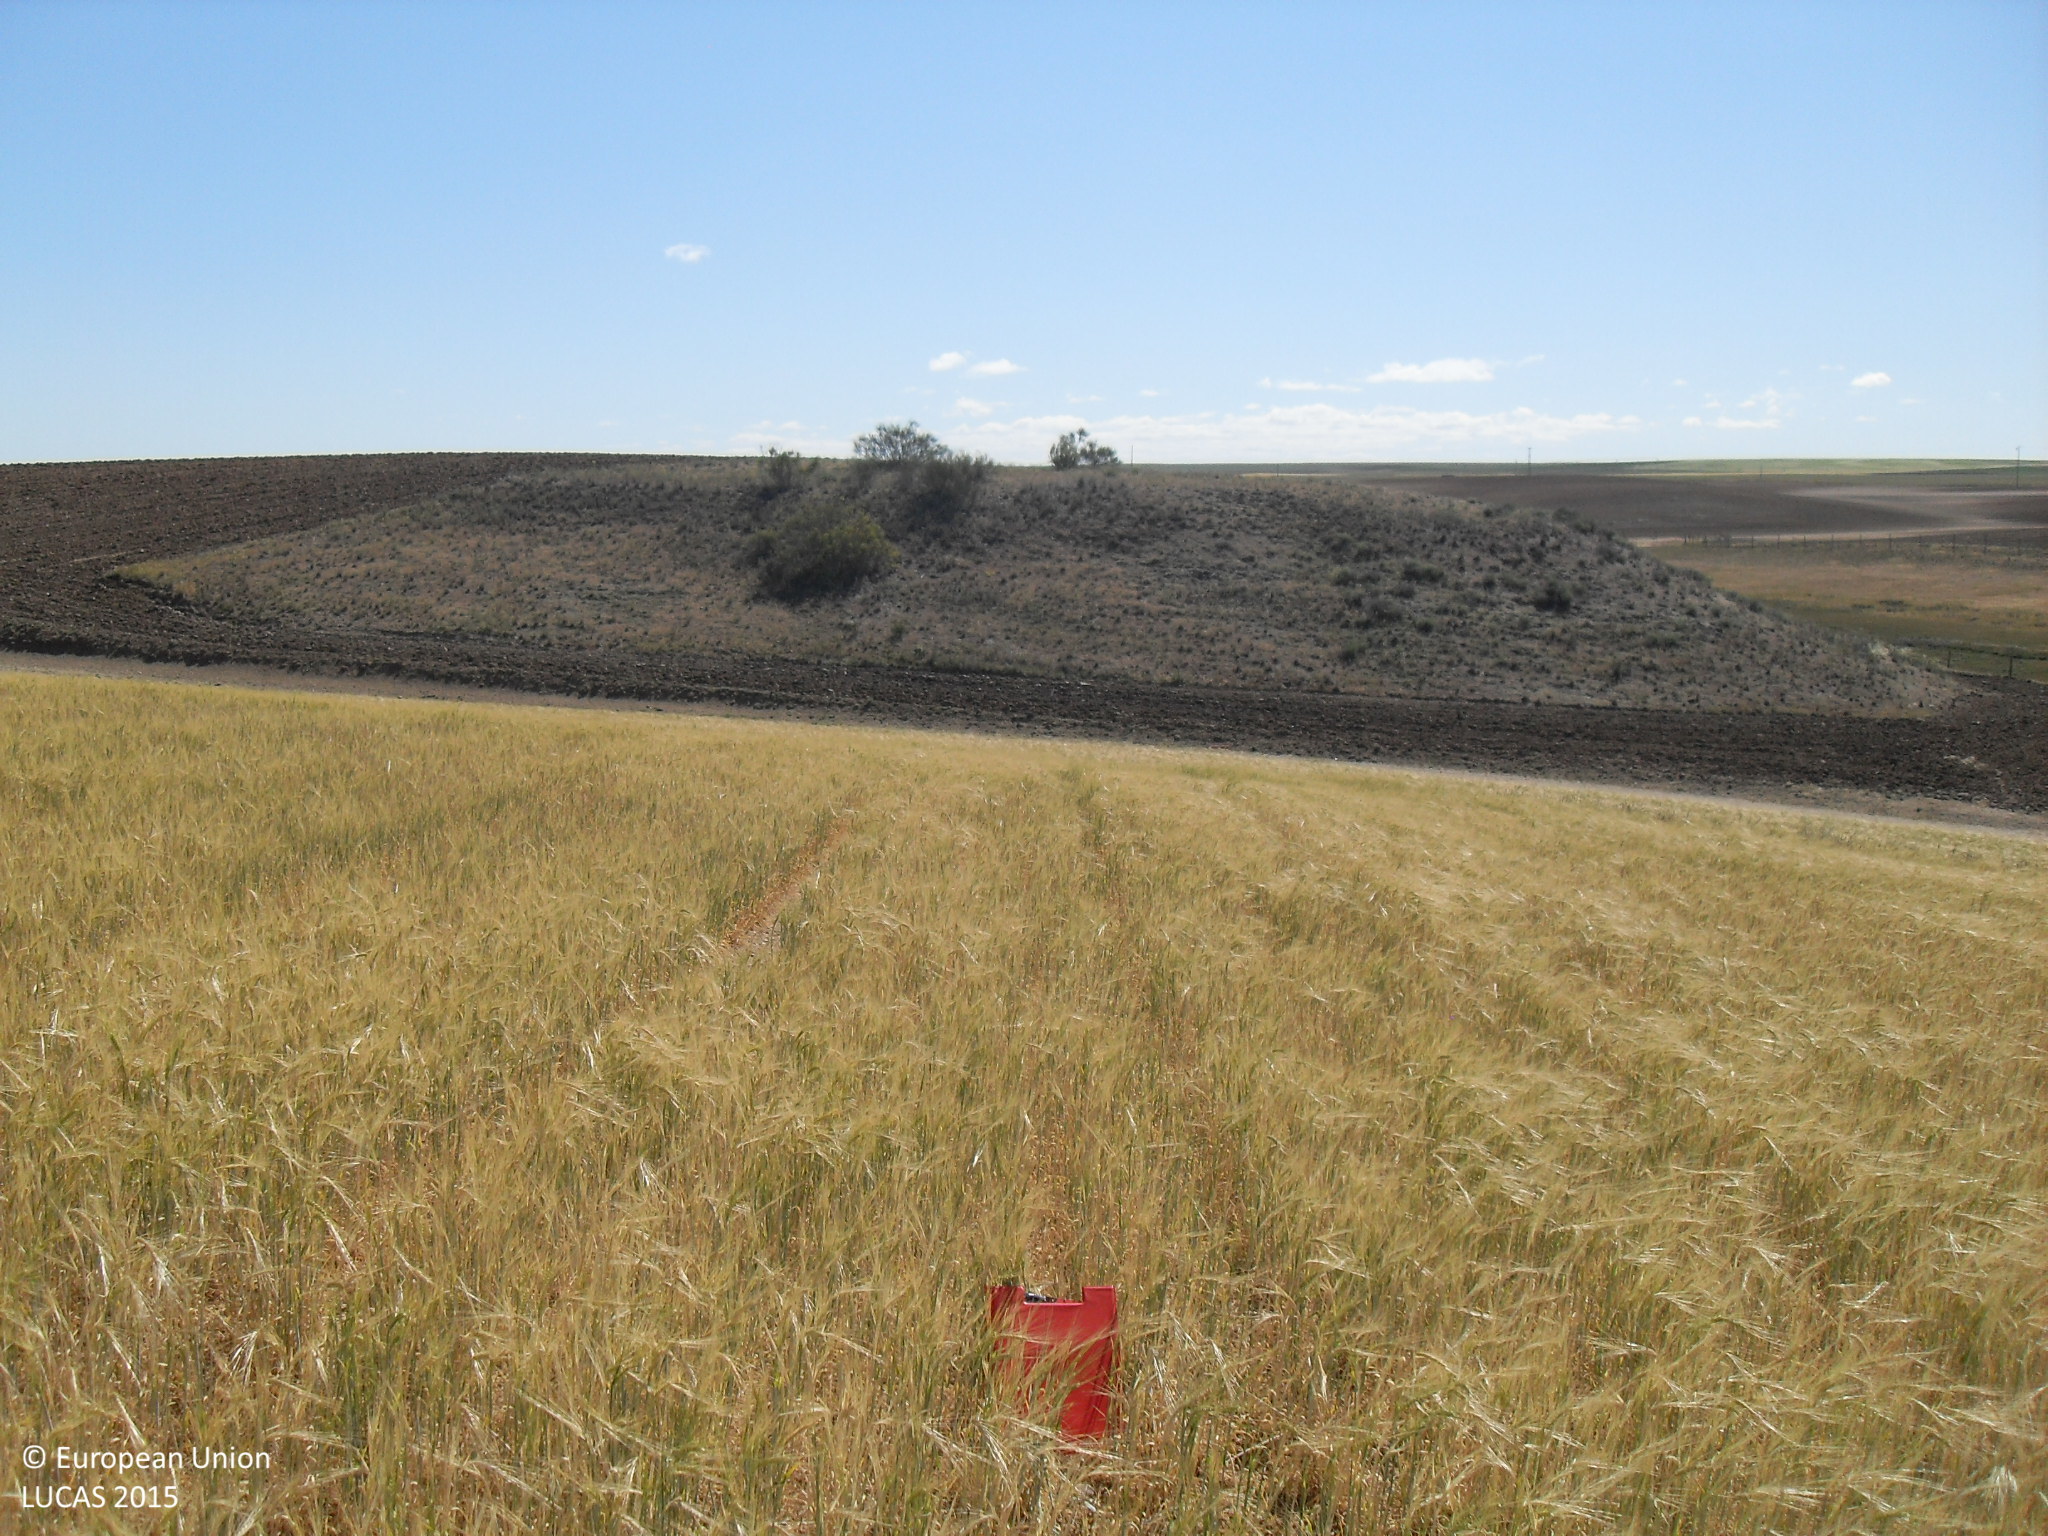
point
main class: Cropland
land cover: Barley
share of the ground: > 75 %
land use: Agriculture (excluding fallow land and kitchen gardens)
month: May
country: ES
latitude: 41.1585
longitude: -5.2666
